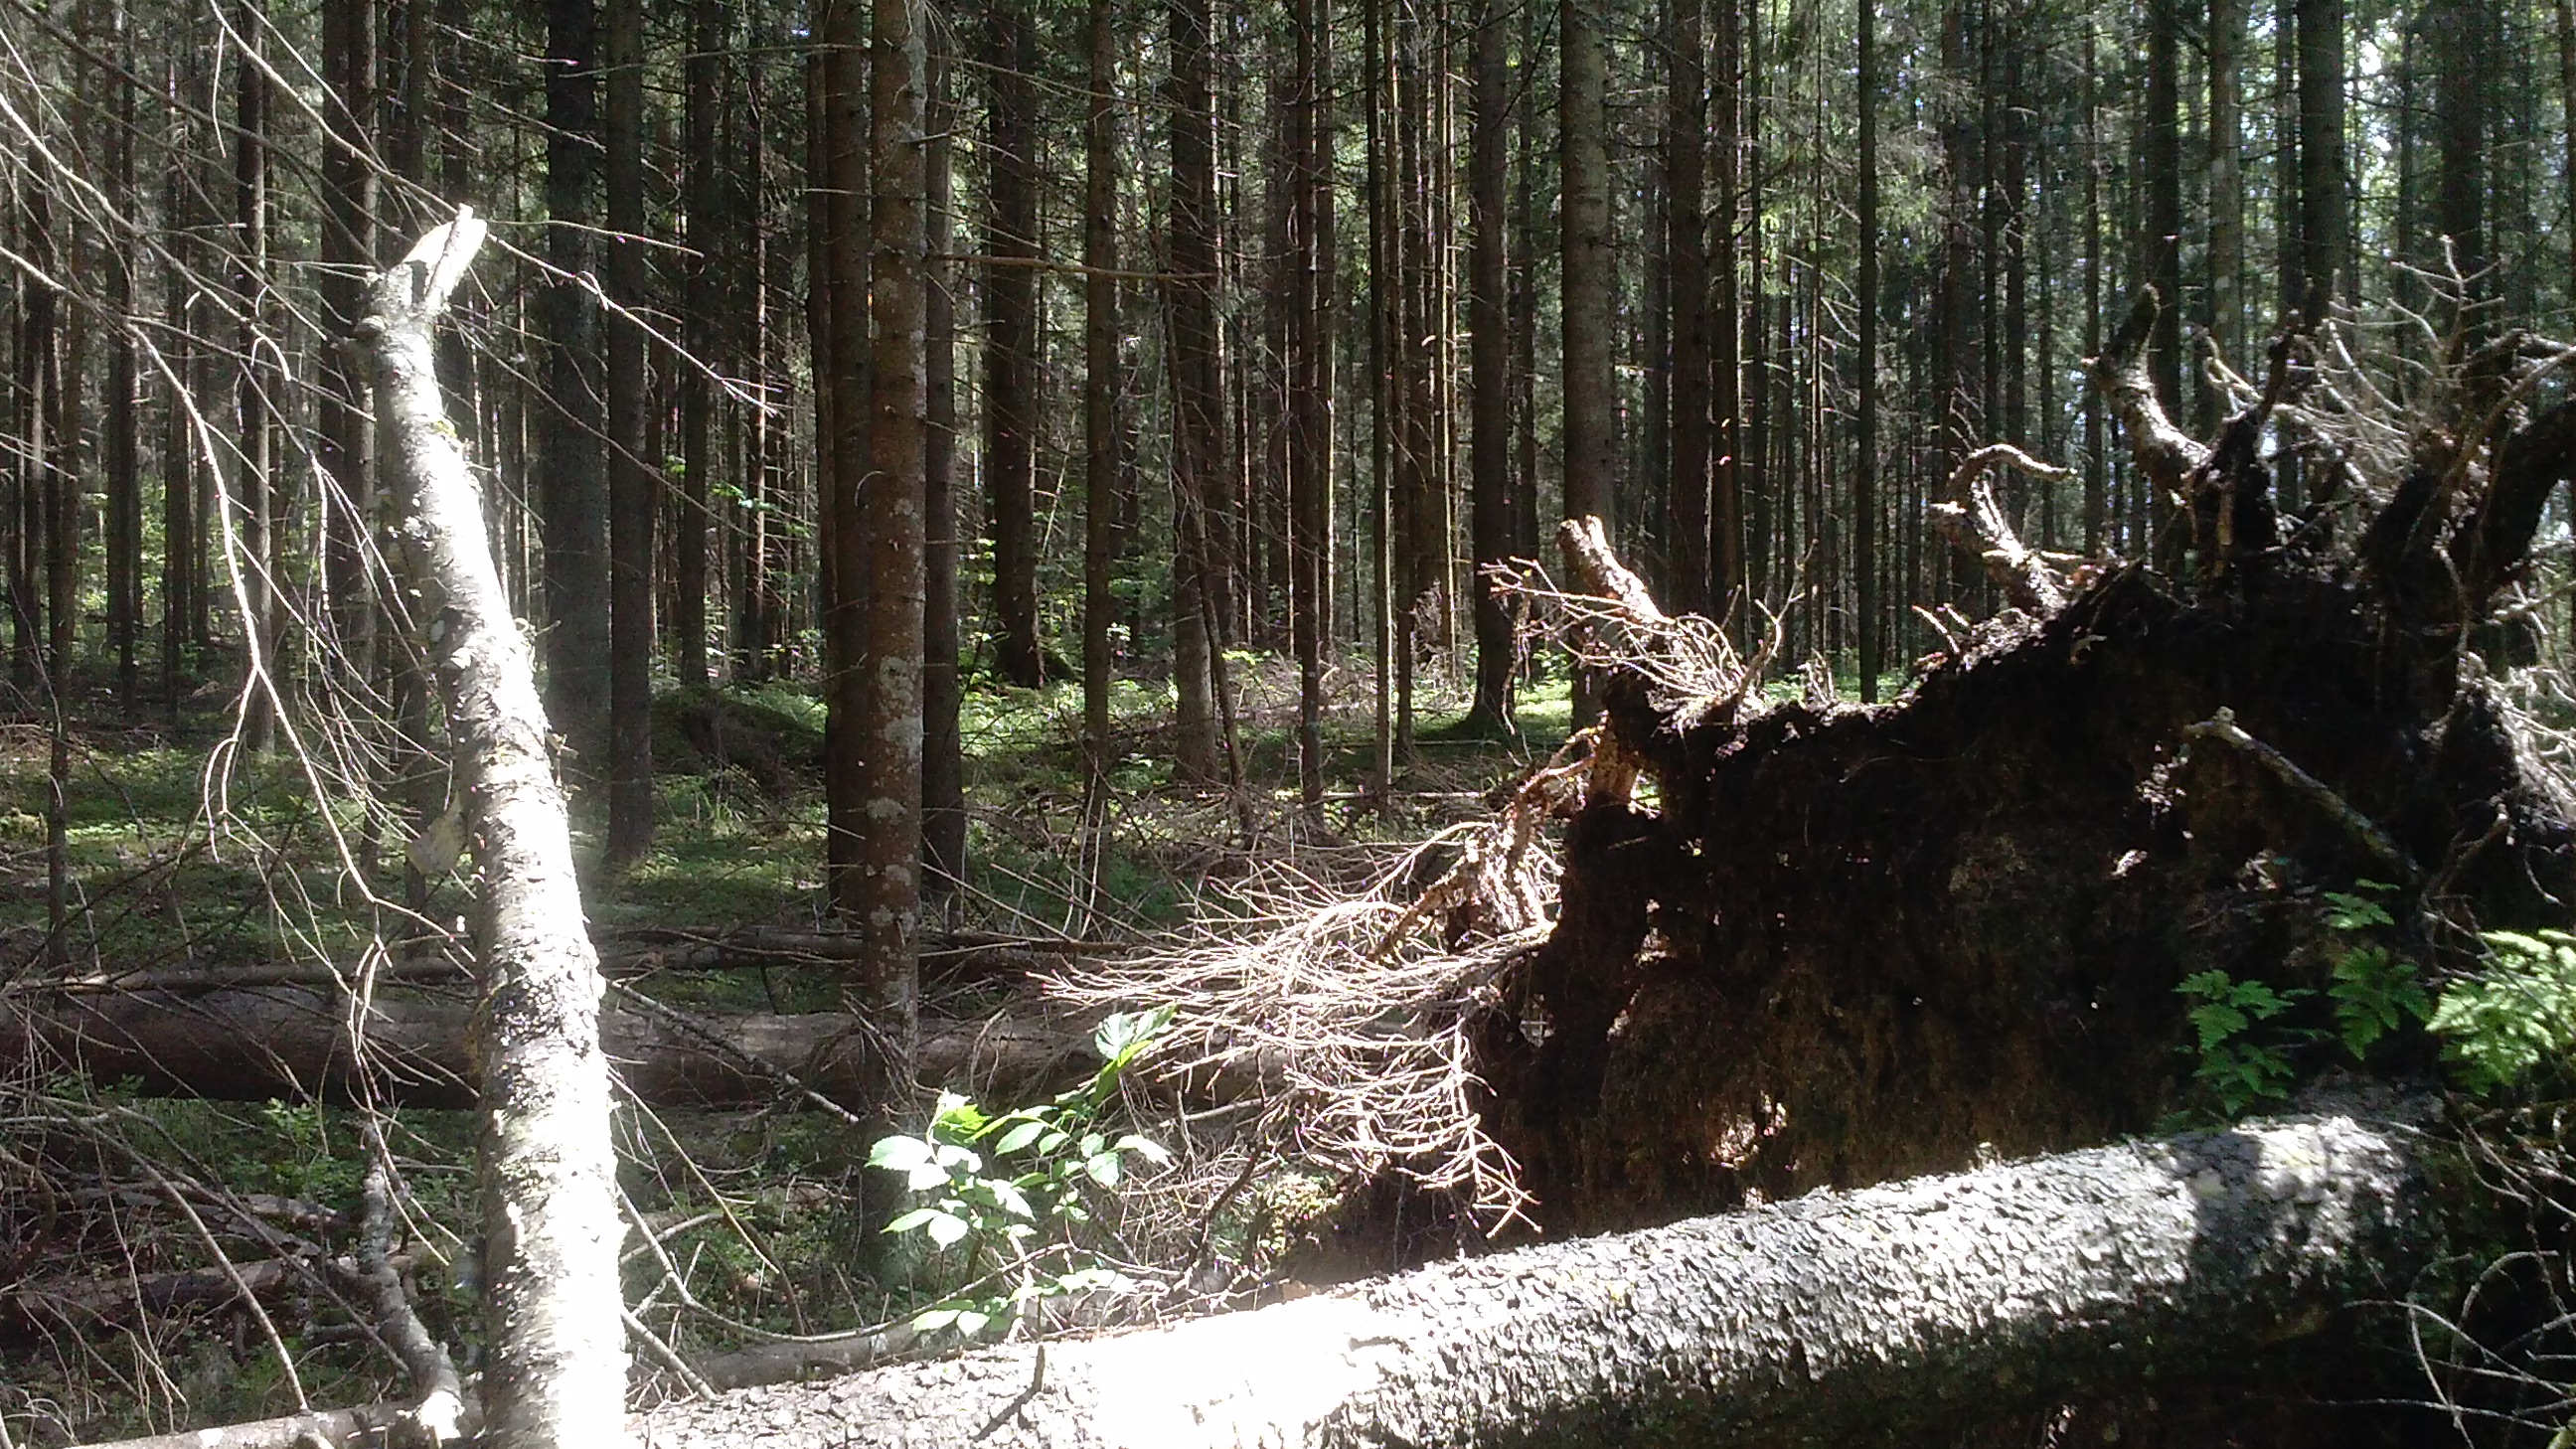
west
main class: Woodland
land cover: Spruce dominated coniferous woodland
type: hemiboreal forest and nemoral coniferous forest and mixed broadleaved-coniferous forest
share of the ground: > 75 %
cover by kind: coniferous forest trees 95 %, broadleaved forest trees 5 %
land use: Forestry
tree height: > 5 m
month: May
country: LV
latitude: 56.2835
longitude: 27.2126
